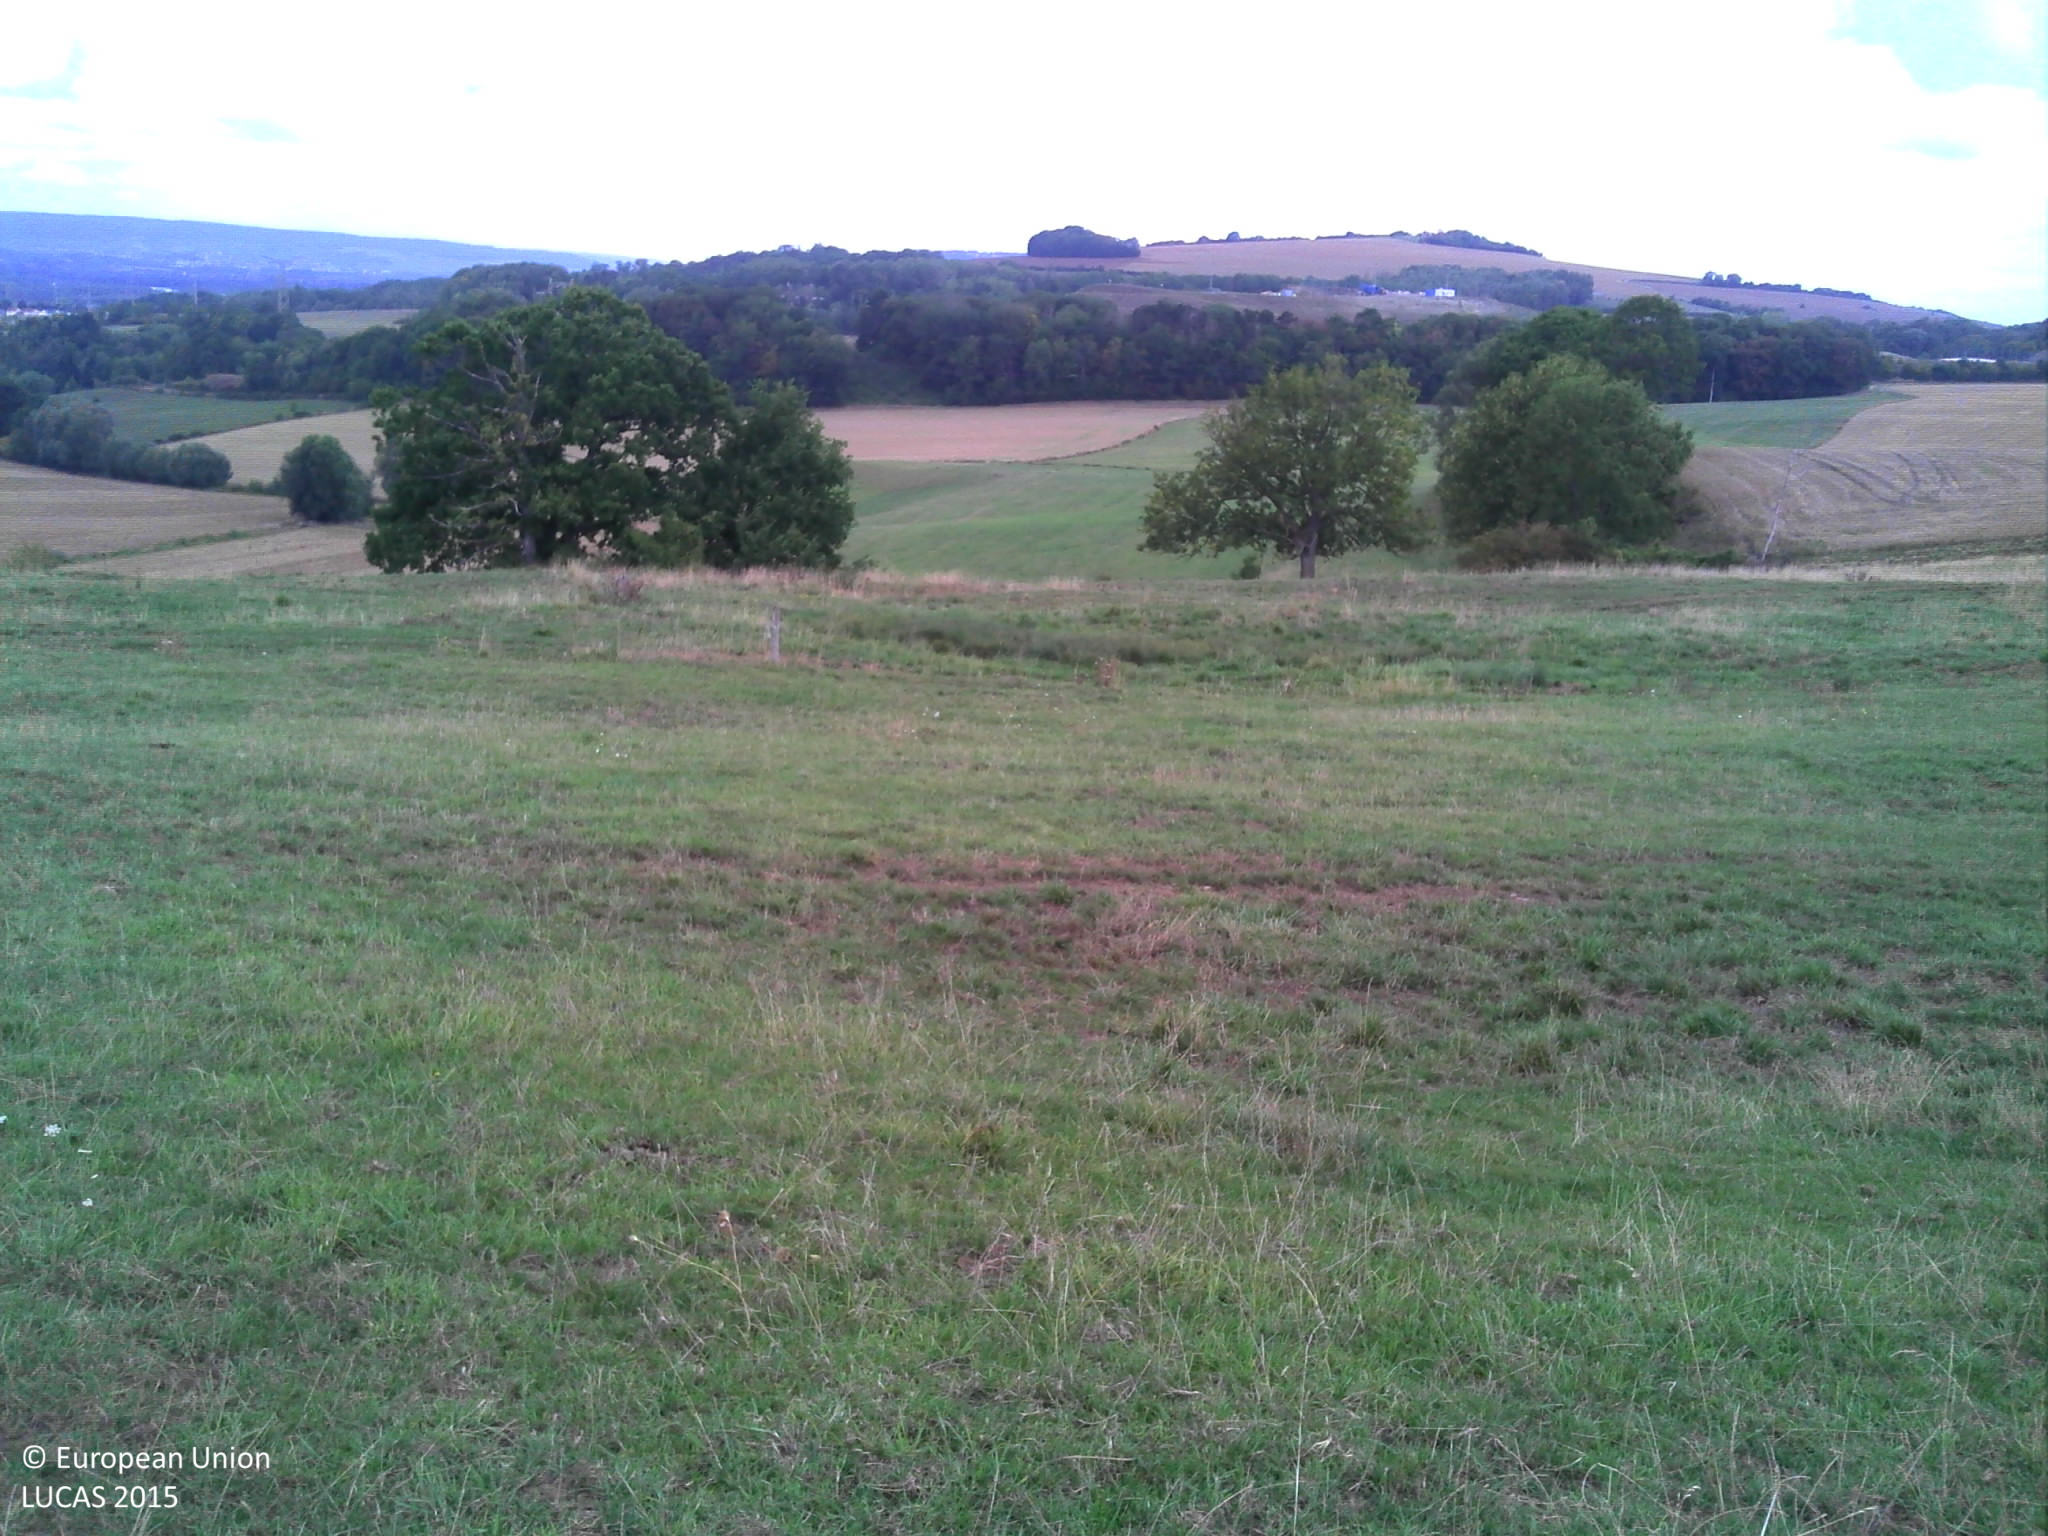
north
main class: Grassland
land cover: Grassland without tree/shrub cover
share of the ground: > 75 %
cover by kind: herbaceous plants 95 %, unconsolidated bare surface 5 %
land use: Agriculture (excluding fallow land and kitchen gardens)
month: September
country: FR
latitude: 48.9106
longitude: 6.0838
